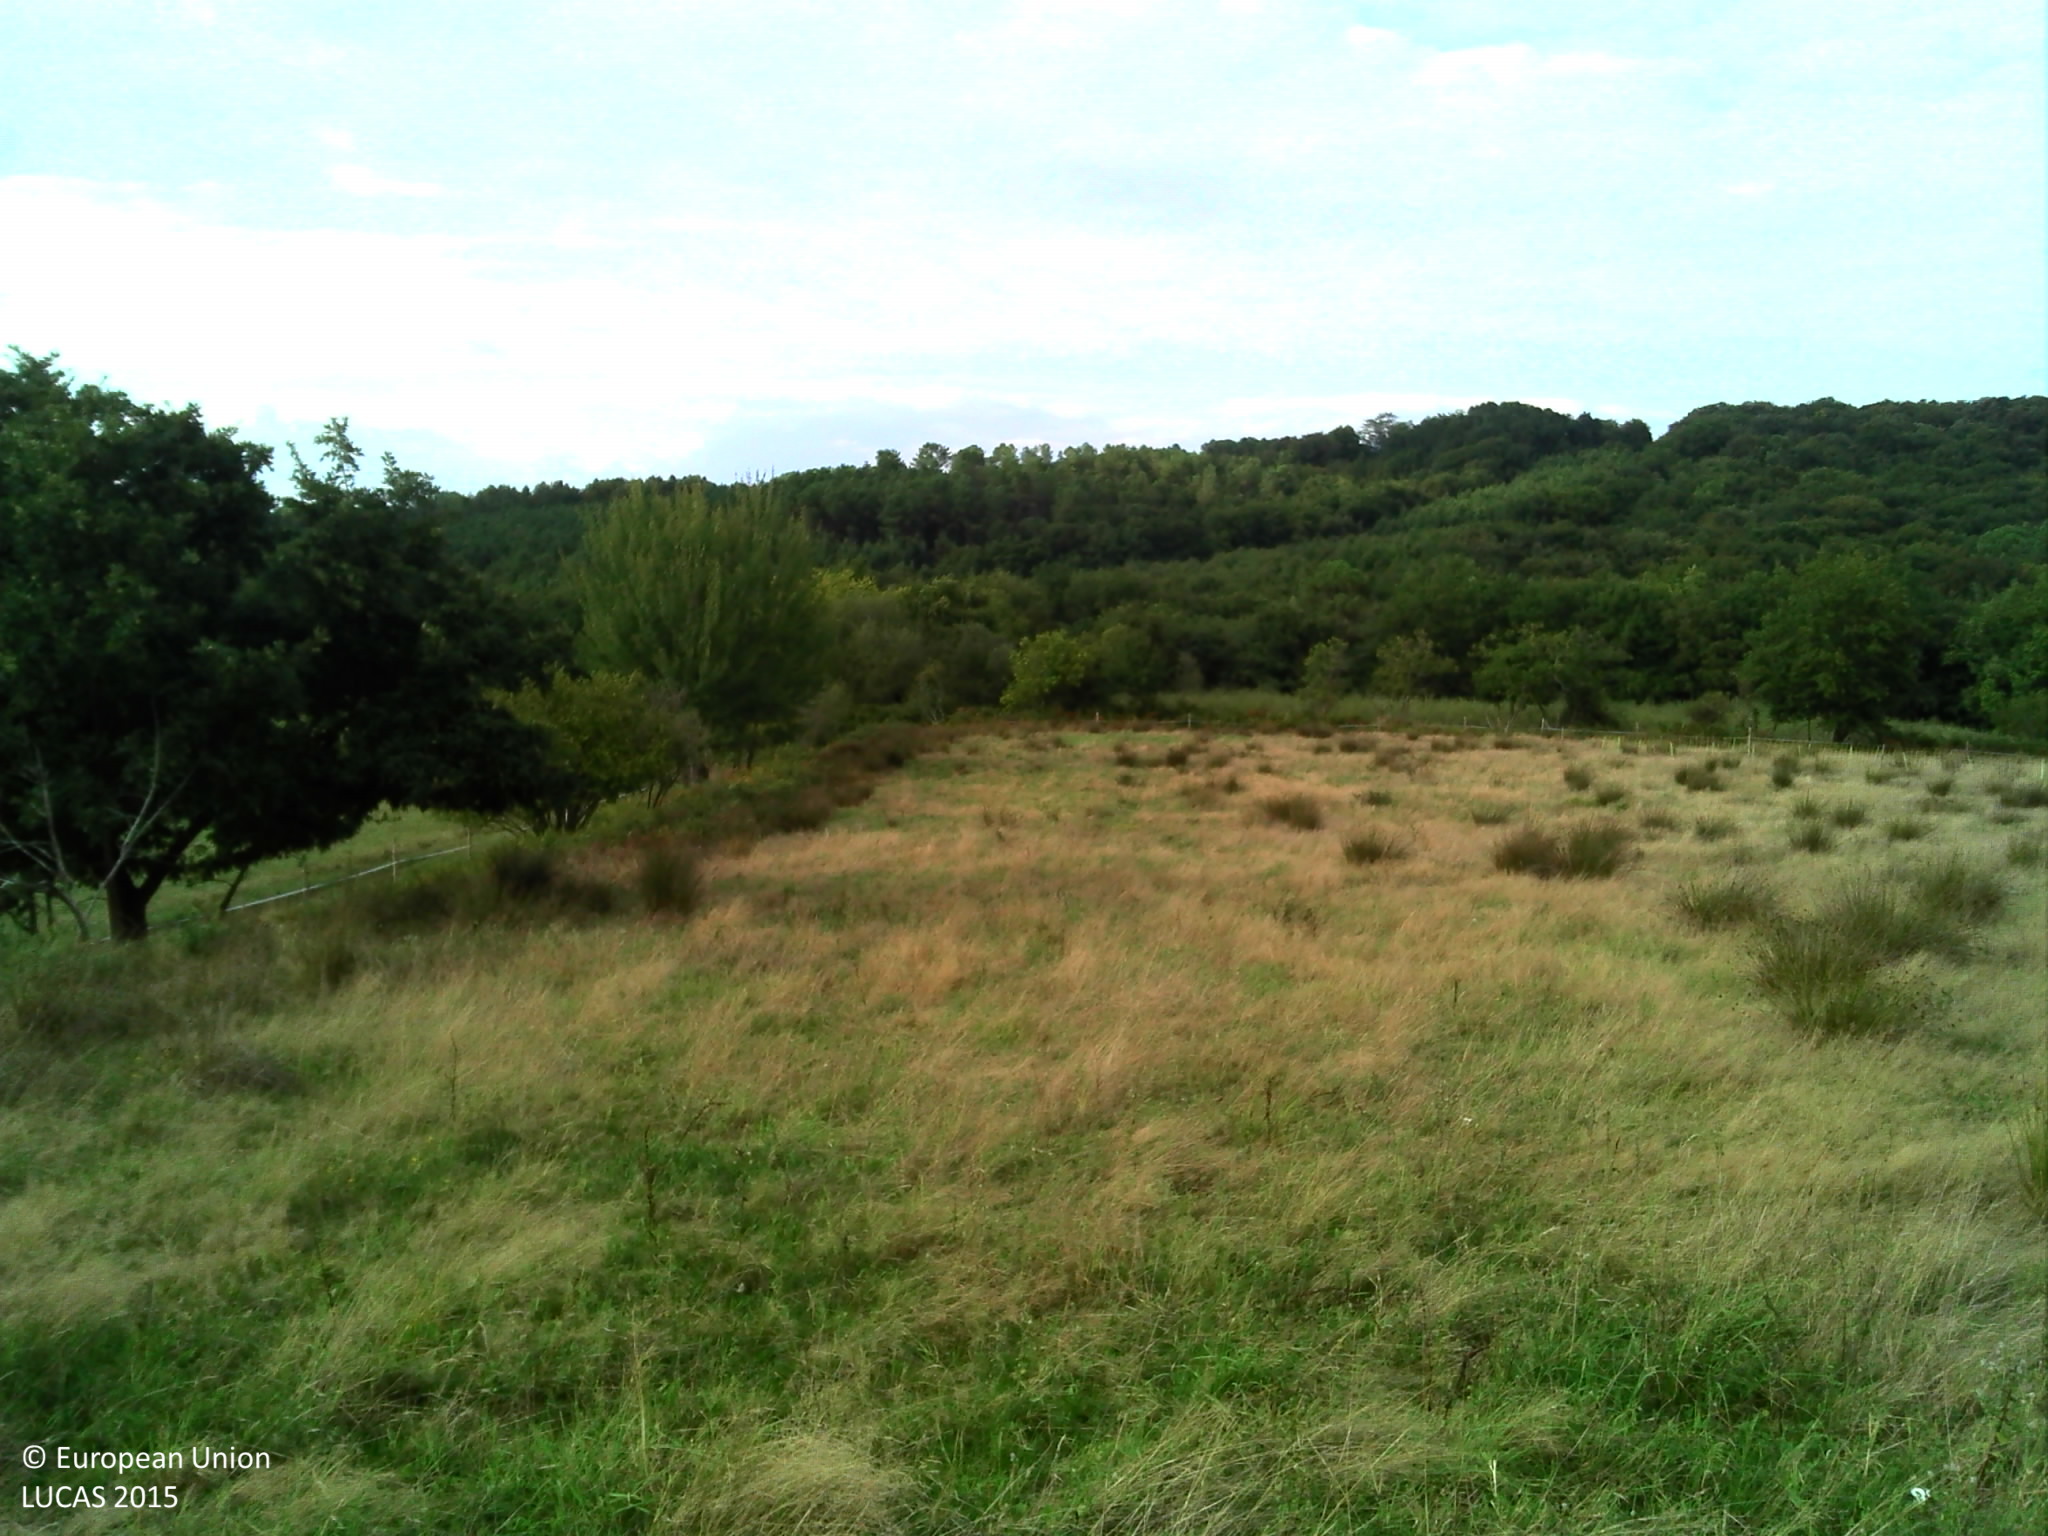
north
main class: Grassland
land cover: Grassland without tree/shrub cover
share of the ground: > 75 %
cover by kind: herbaceous plants 100 %
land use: Agriculture (excluding fallow land and kitchen gardens)
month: September
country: FR
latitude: 43.5216
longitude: -0.5382
